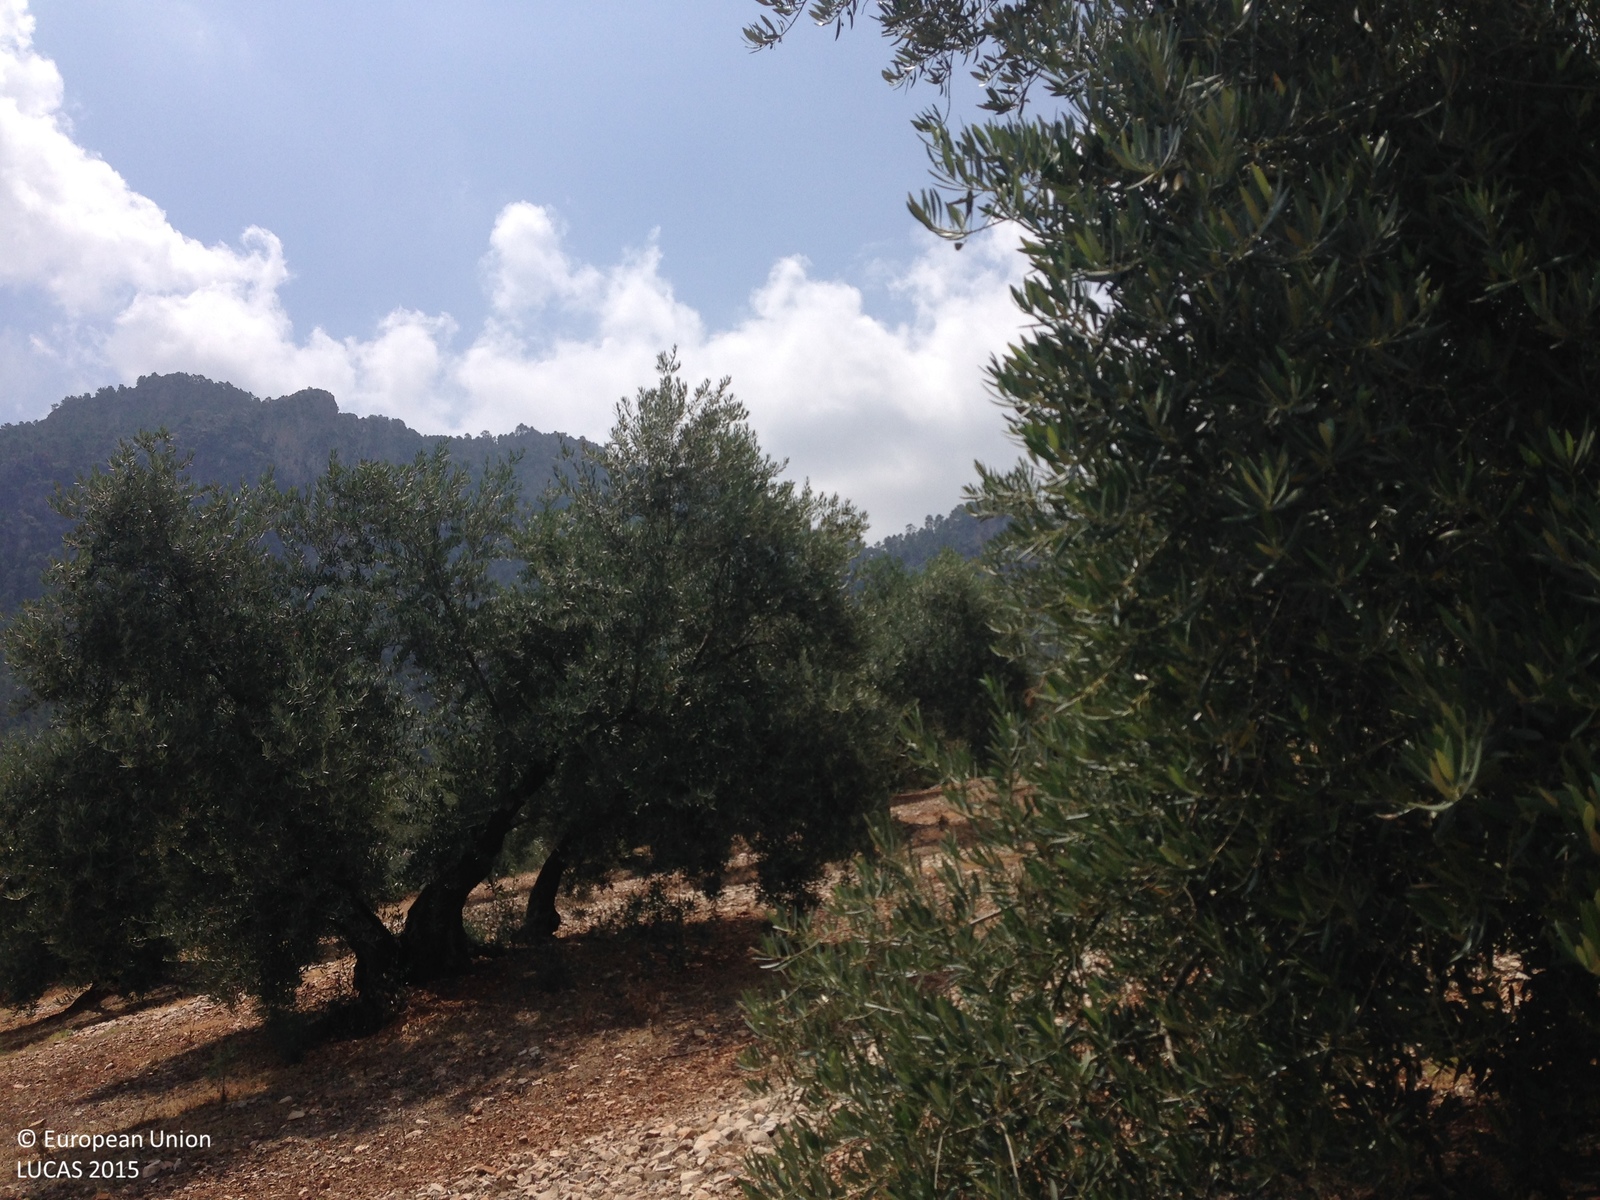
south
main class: Cropland
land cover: Olive groves
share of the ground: 25 - 50 %
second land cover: Other bare soil
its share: > 75 %
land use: Agriculture (excluding fallow land and kitchen gardens)
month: June
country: ES
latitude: 38.1657
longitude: -2.9068
